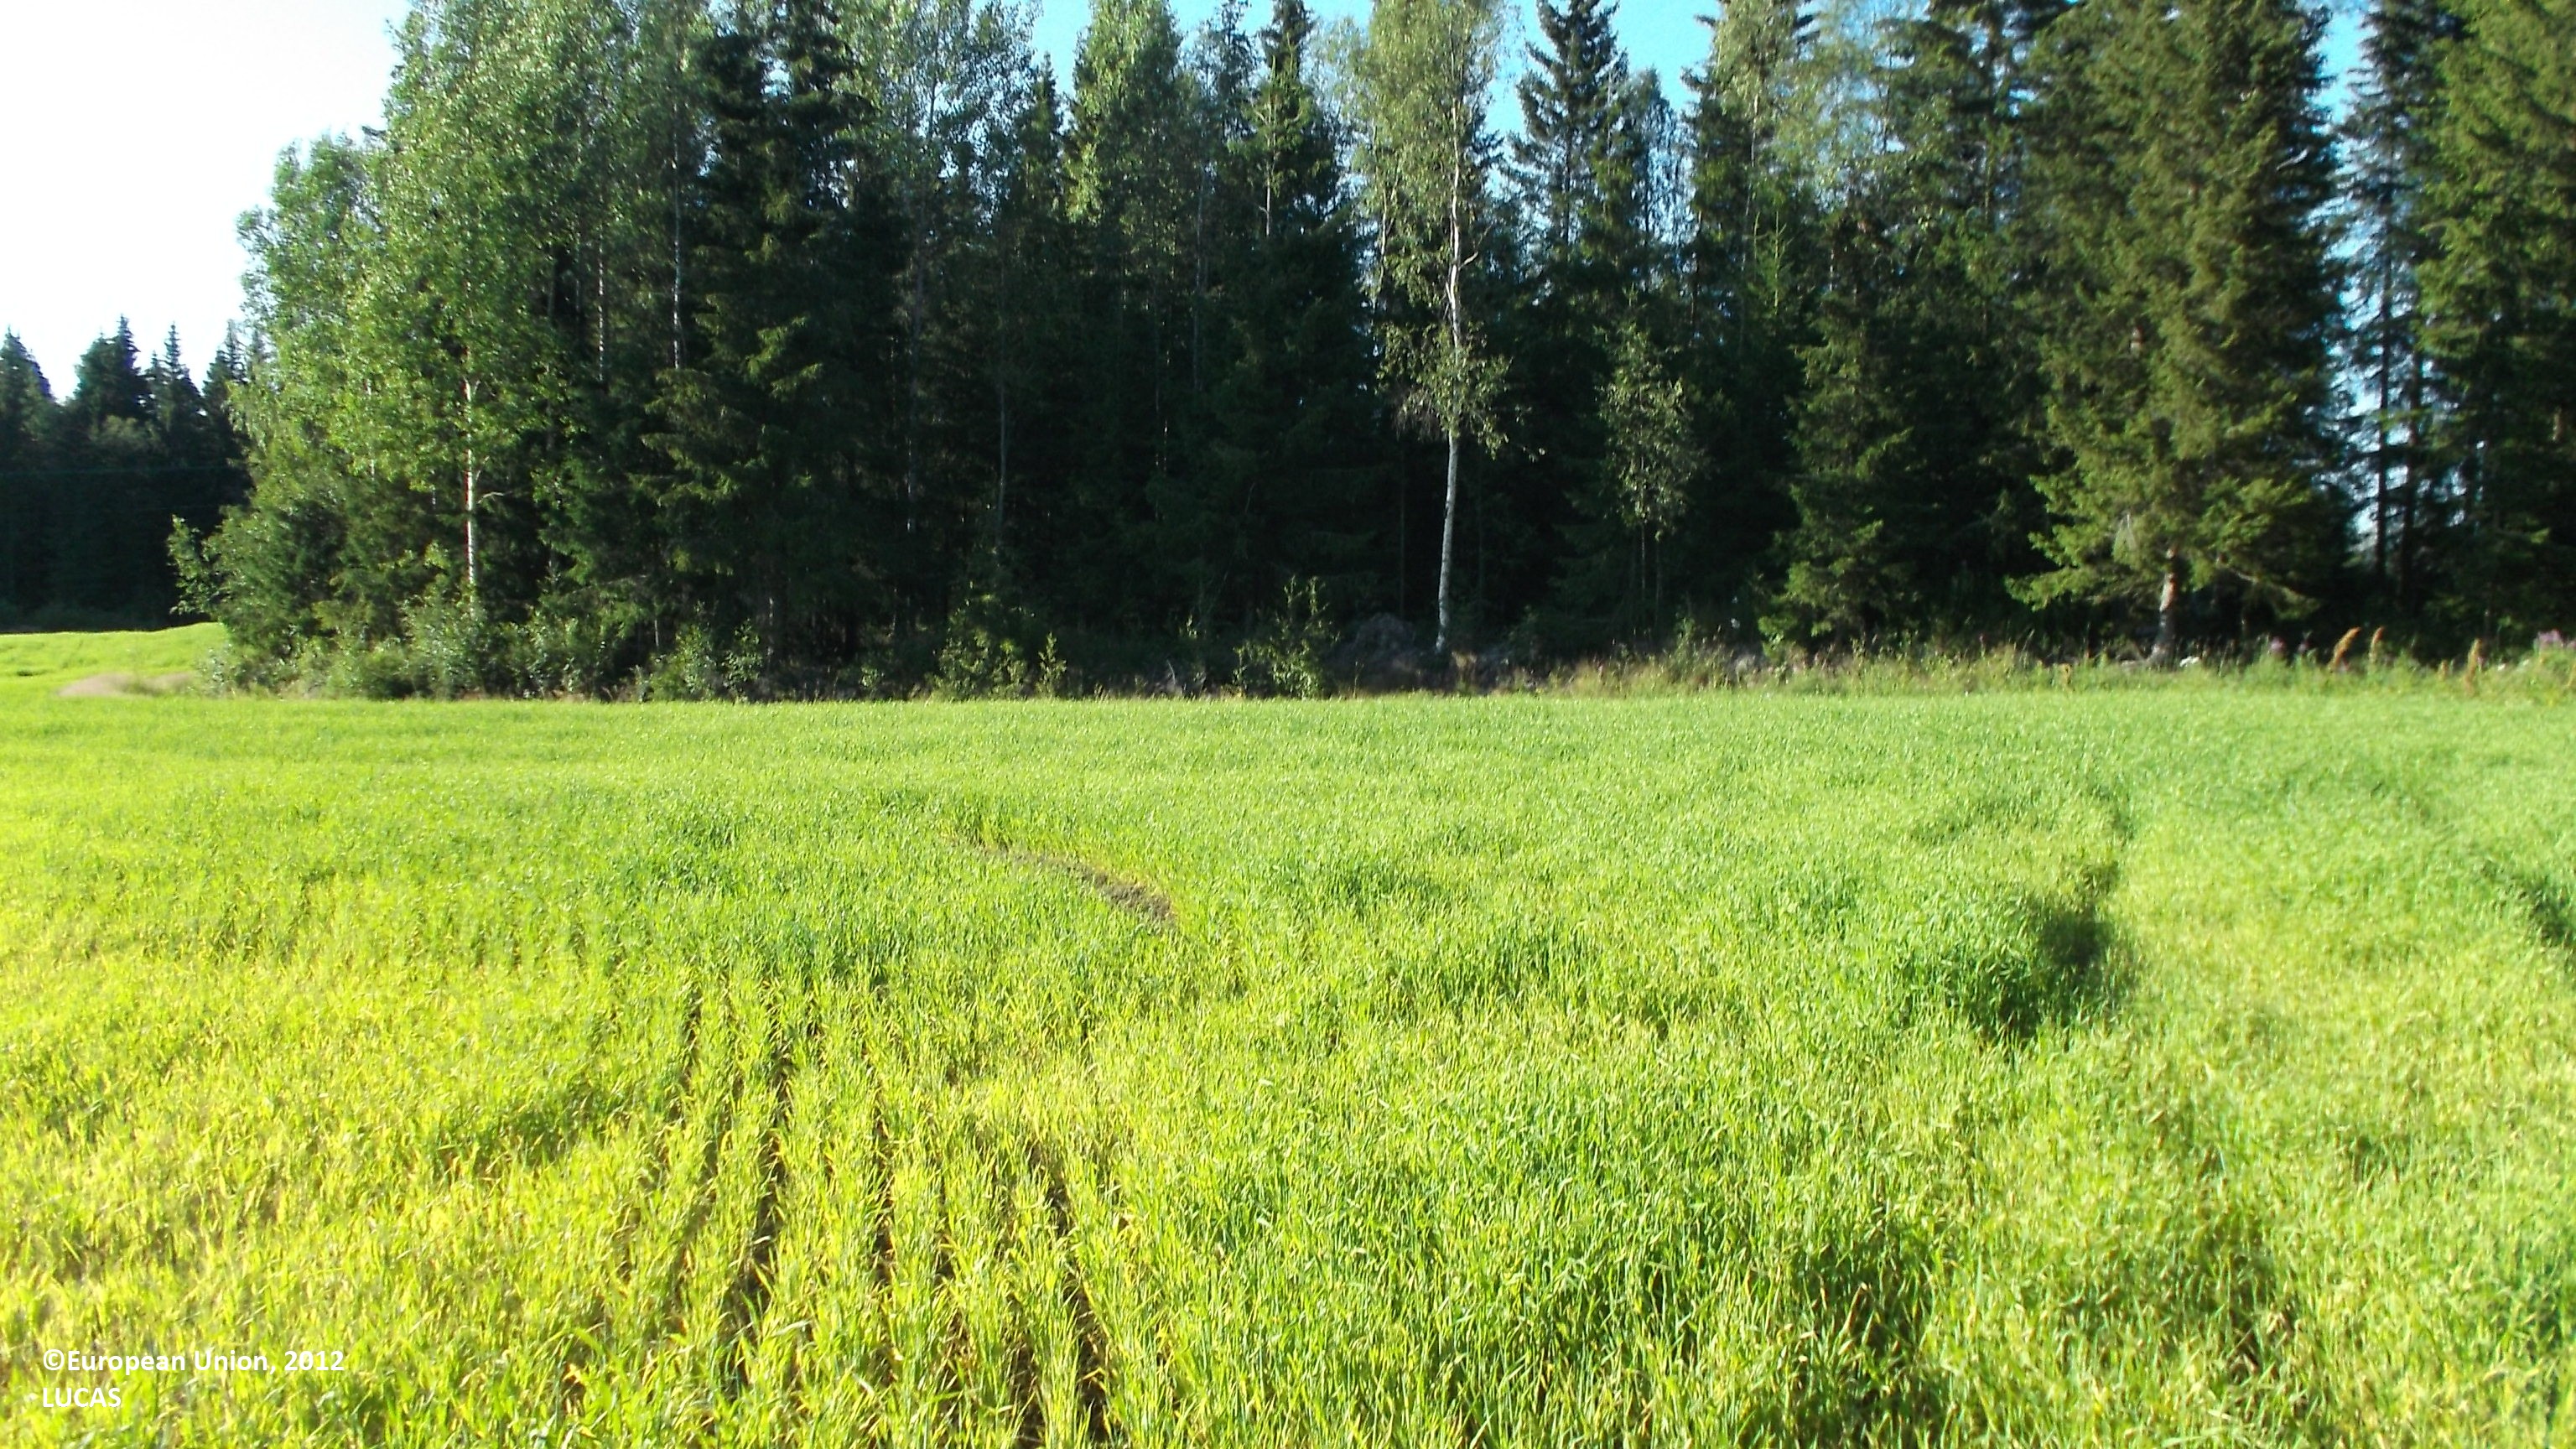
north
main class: Cropland
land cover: Barley
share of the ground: > 75 %
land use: Agriculture (excluding fallow land and kitchen gardens)
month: July
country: FI
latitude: 63.6832
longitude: 22.9299
